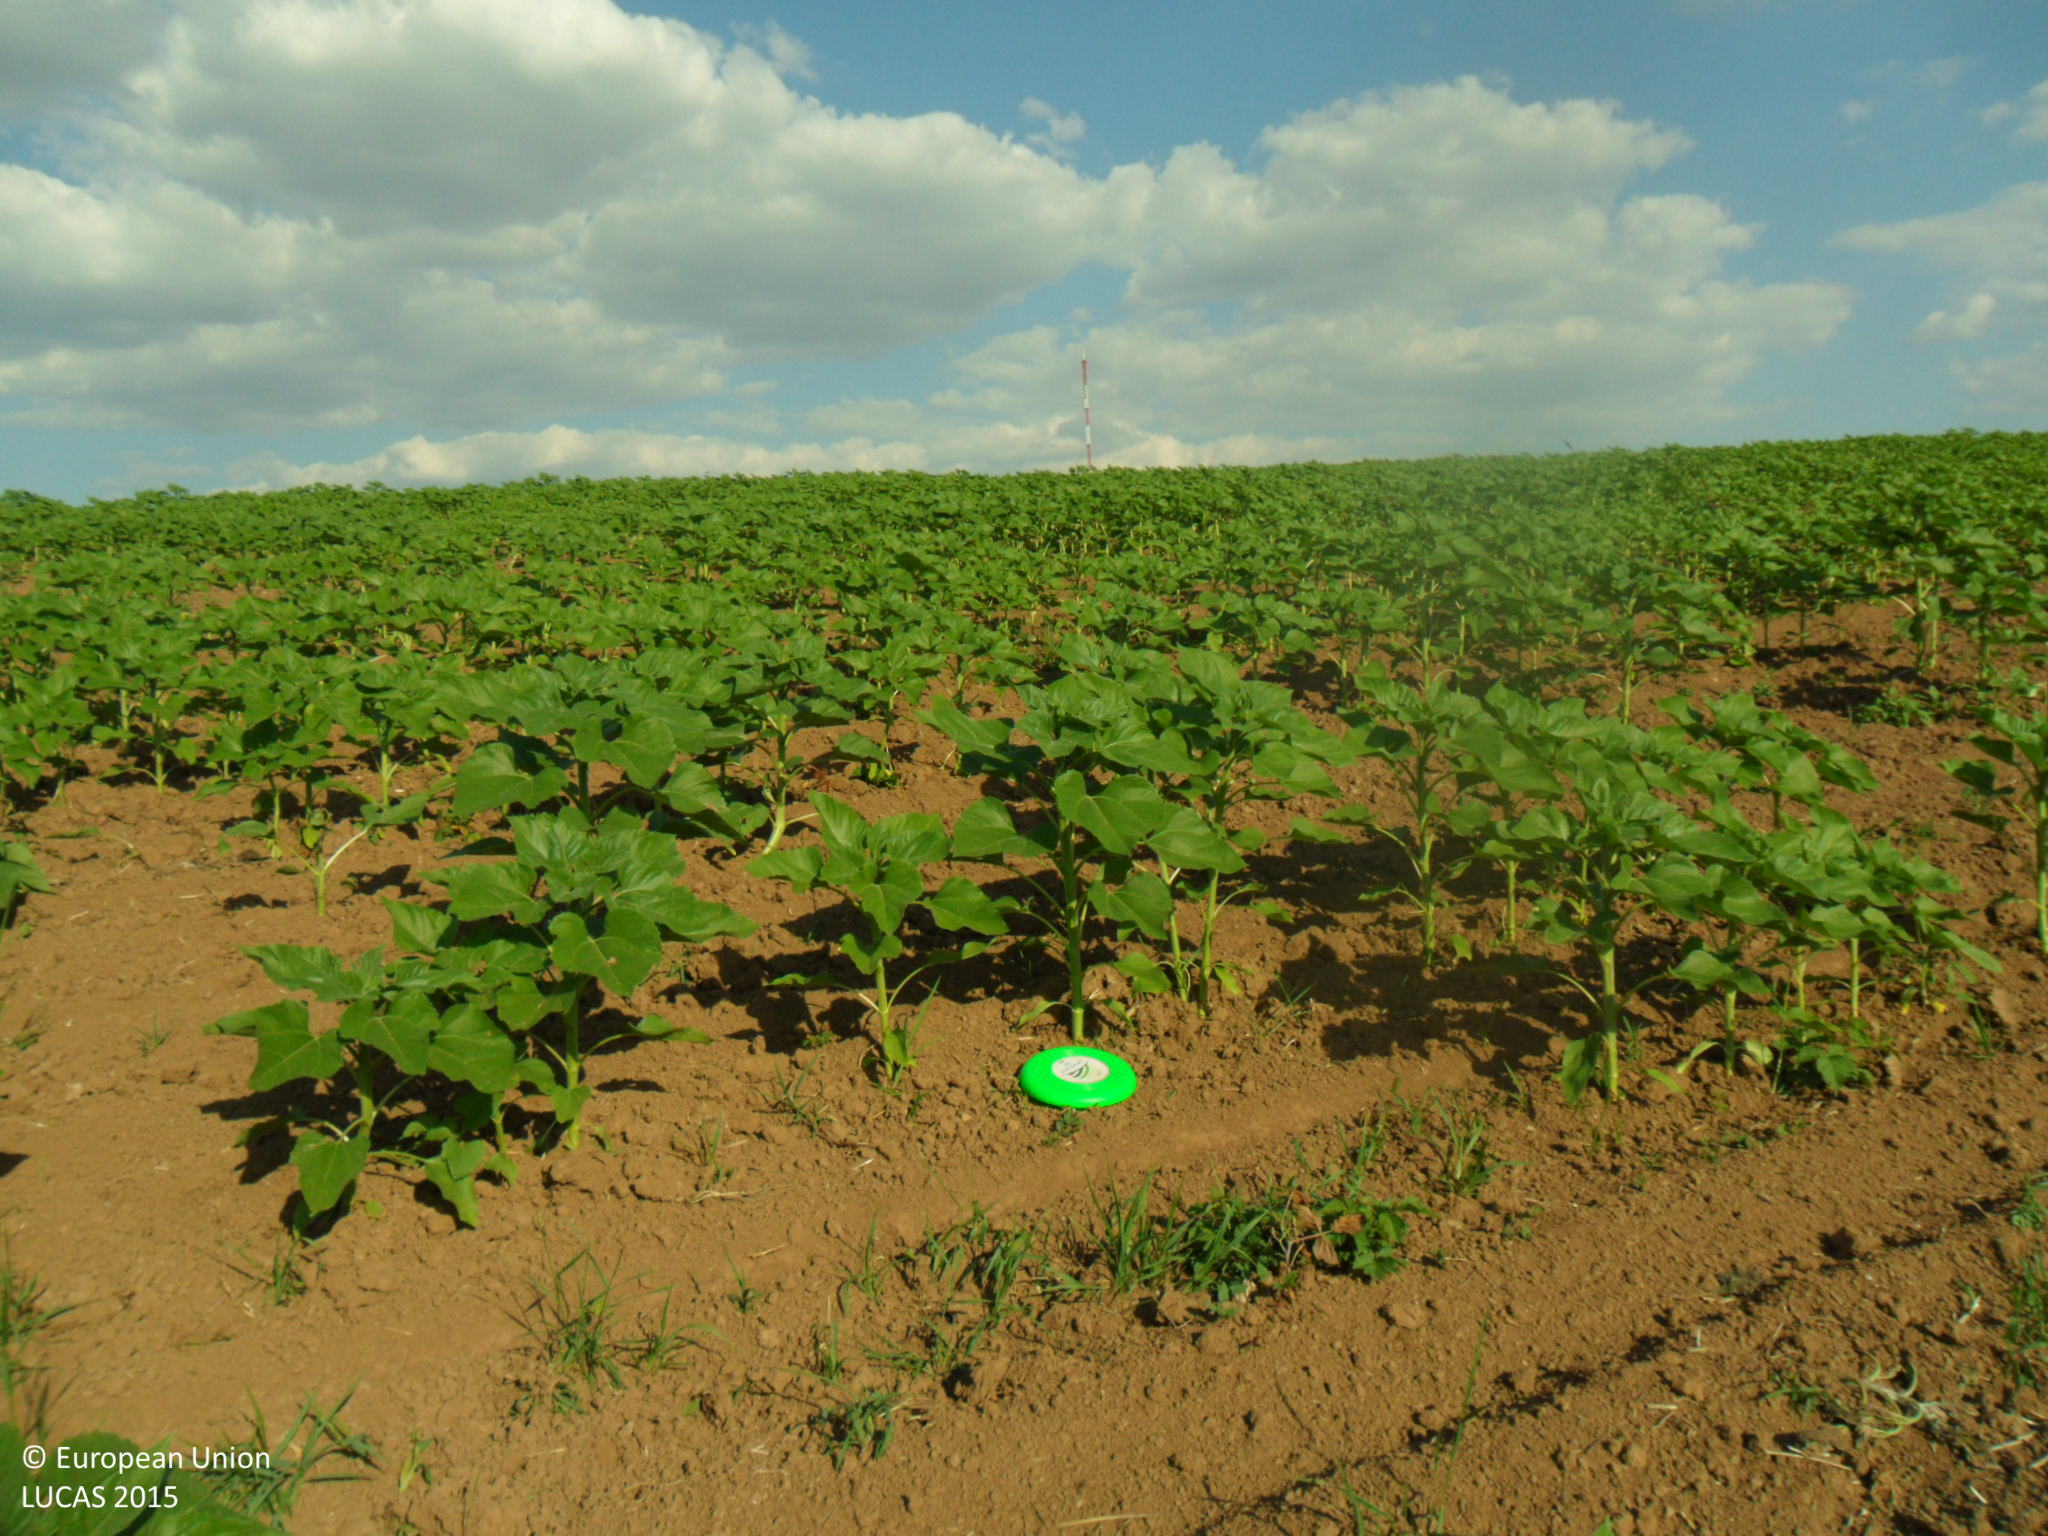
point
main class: Cropland
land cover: Sunflower
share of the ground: 50 - 75 %
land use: Agriculture (excluding fallow land and kitchen gardens)
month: June
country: BG
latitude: 43.5083
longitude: 26.8744
